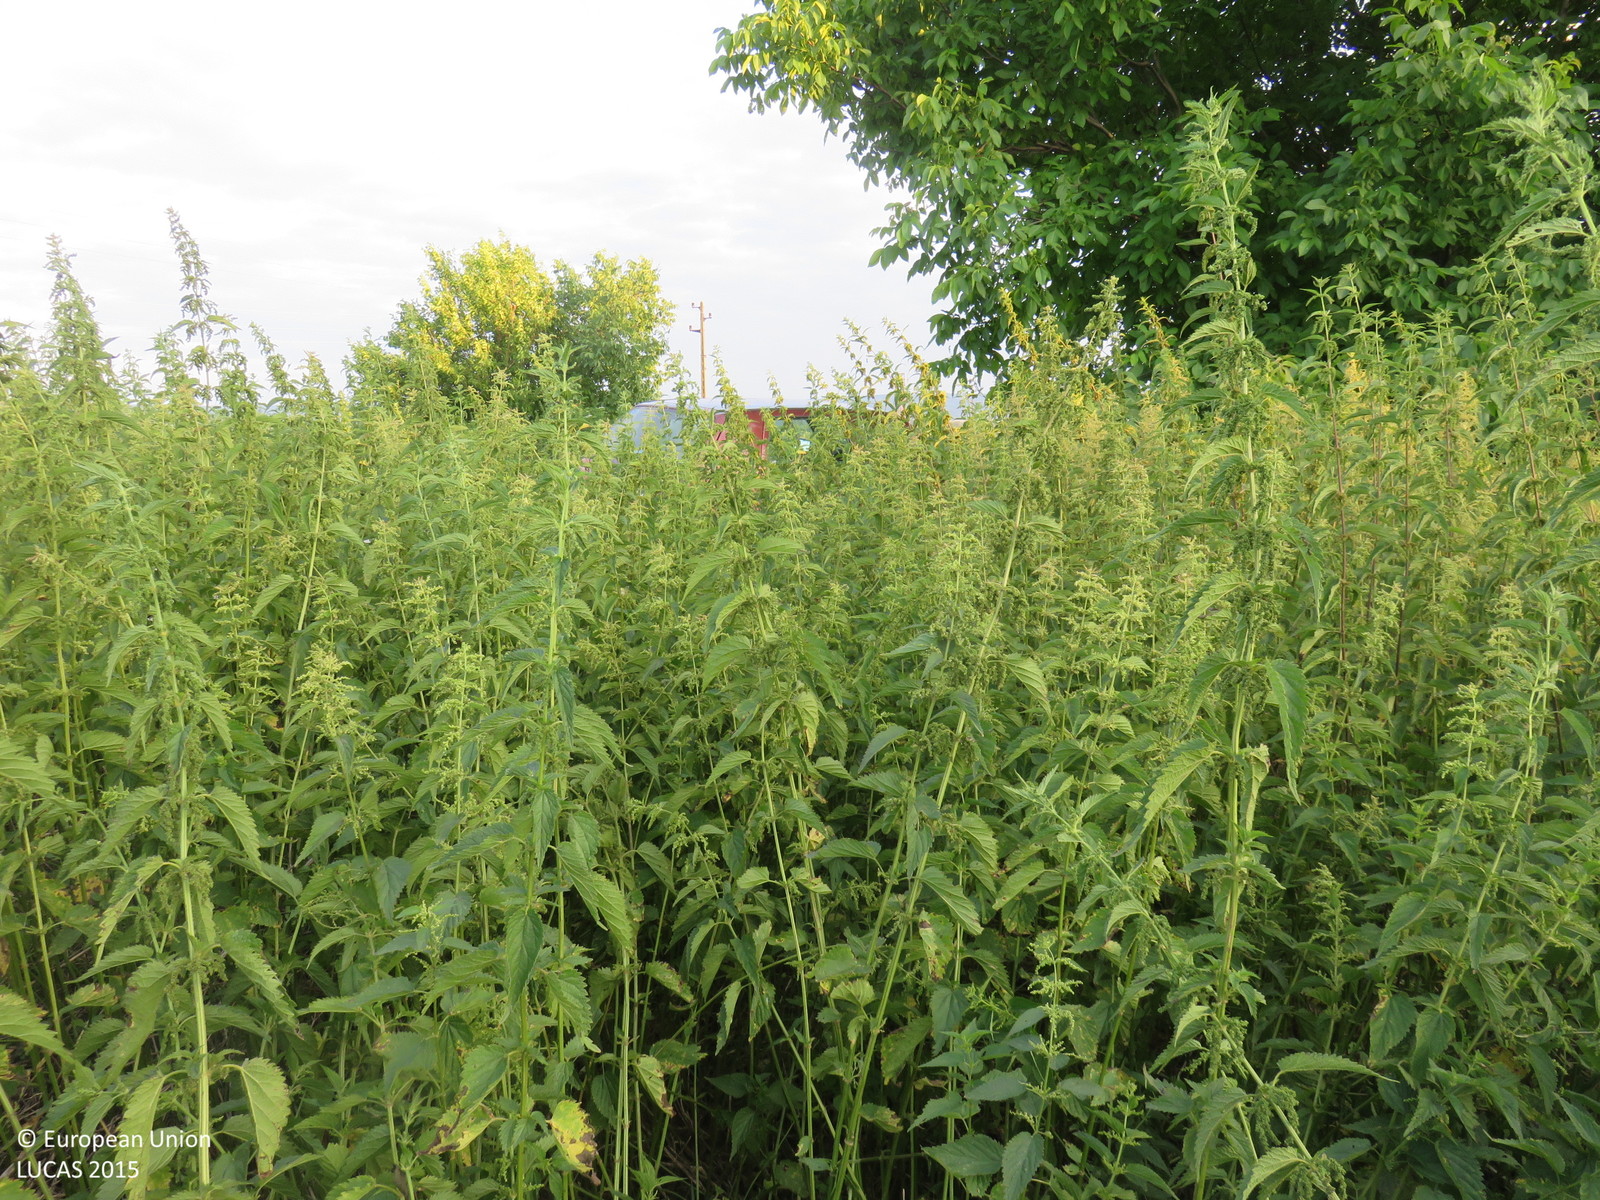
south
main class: Grassland
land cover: Grassland with sparse tree/shrub cover
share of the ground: > 75 %
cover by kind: herbaceous plants 95 %, broadleaved forest trees 5 %
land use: Agriculture (excluding fallow land and kitchen gardens)
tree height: > 5 m
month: June
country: BG
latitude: 43.3148
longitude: 25.0762
